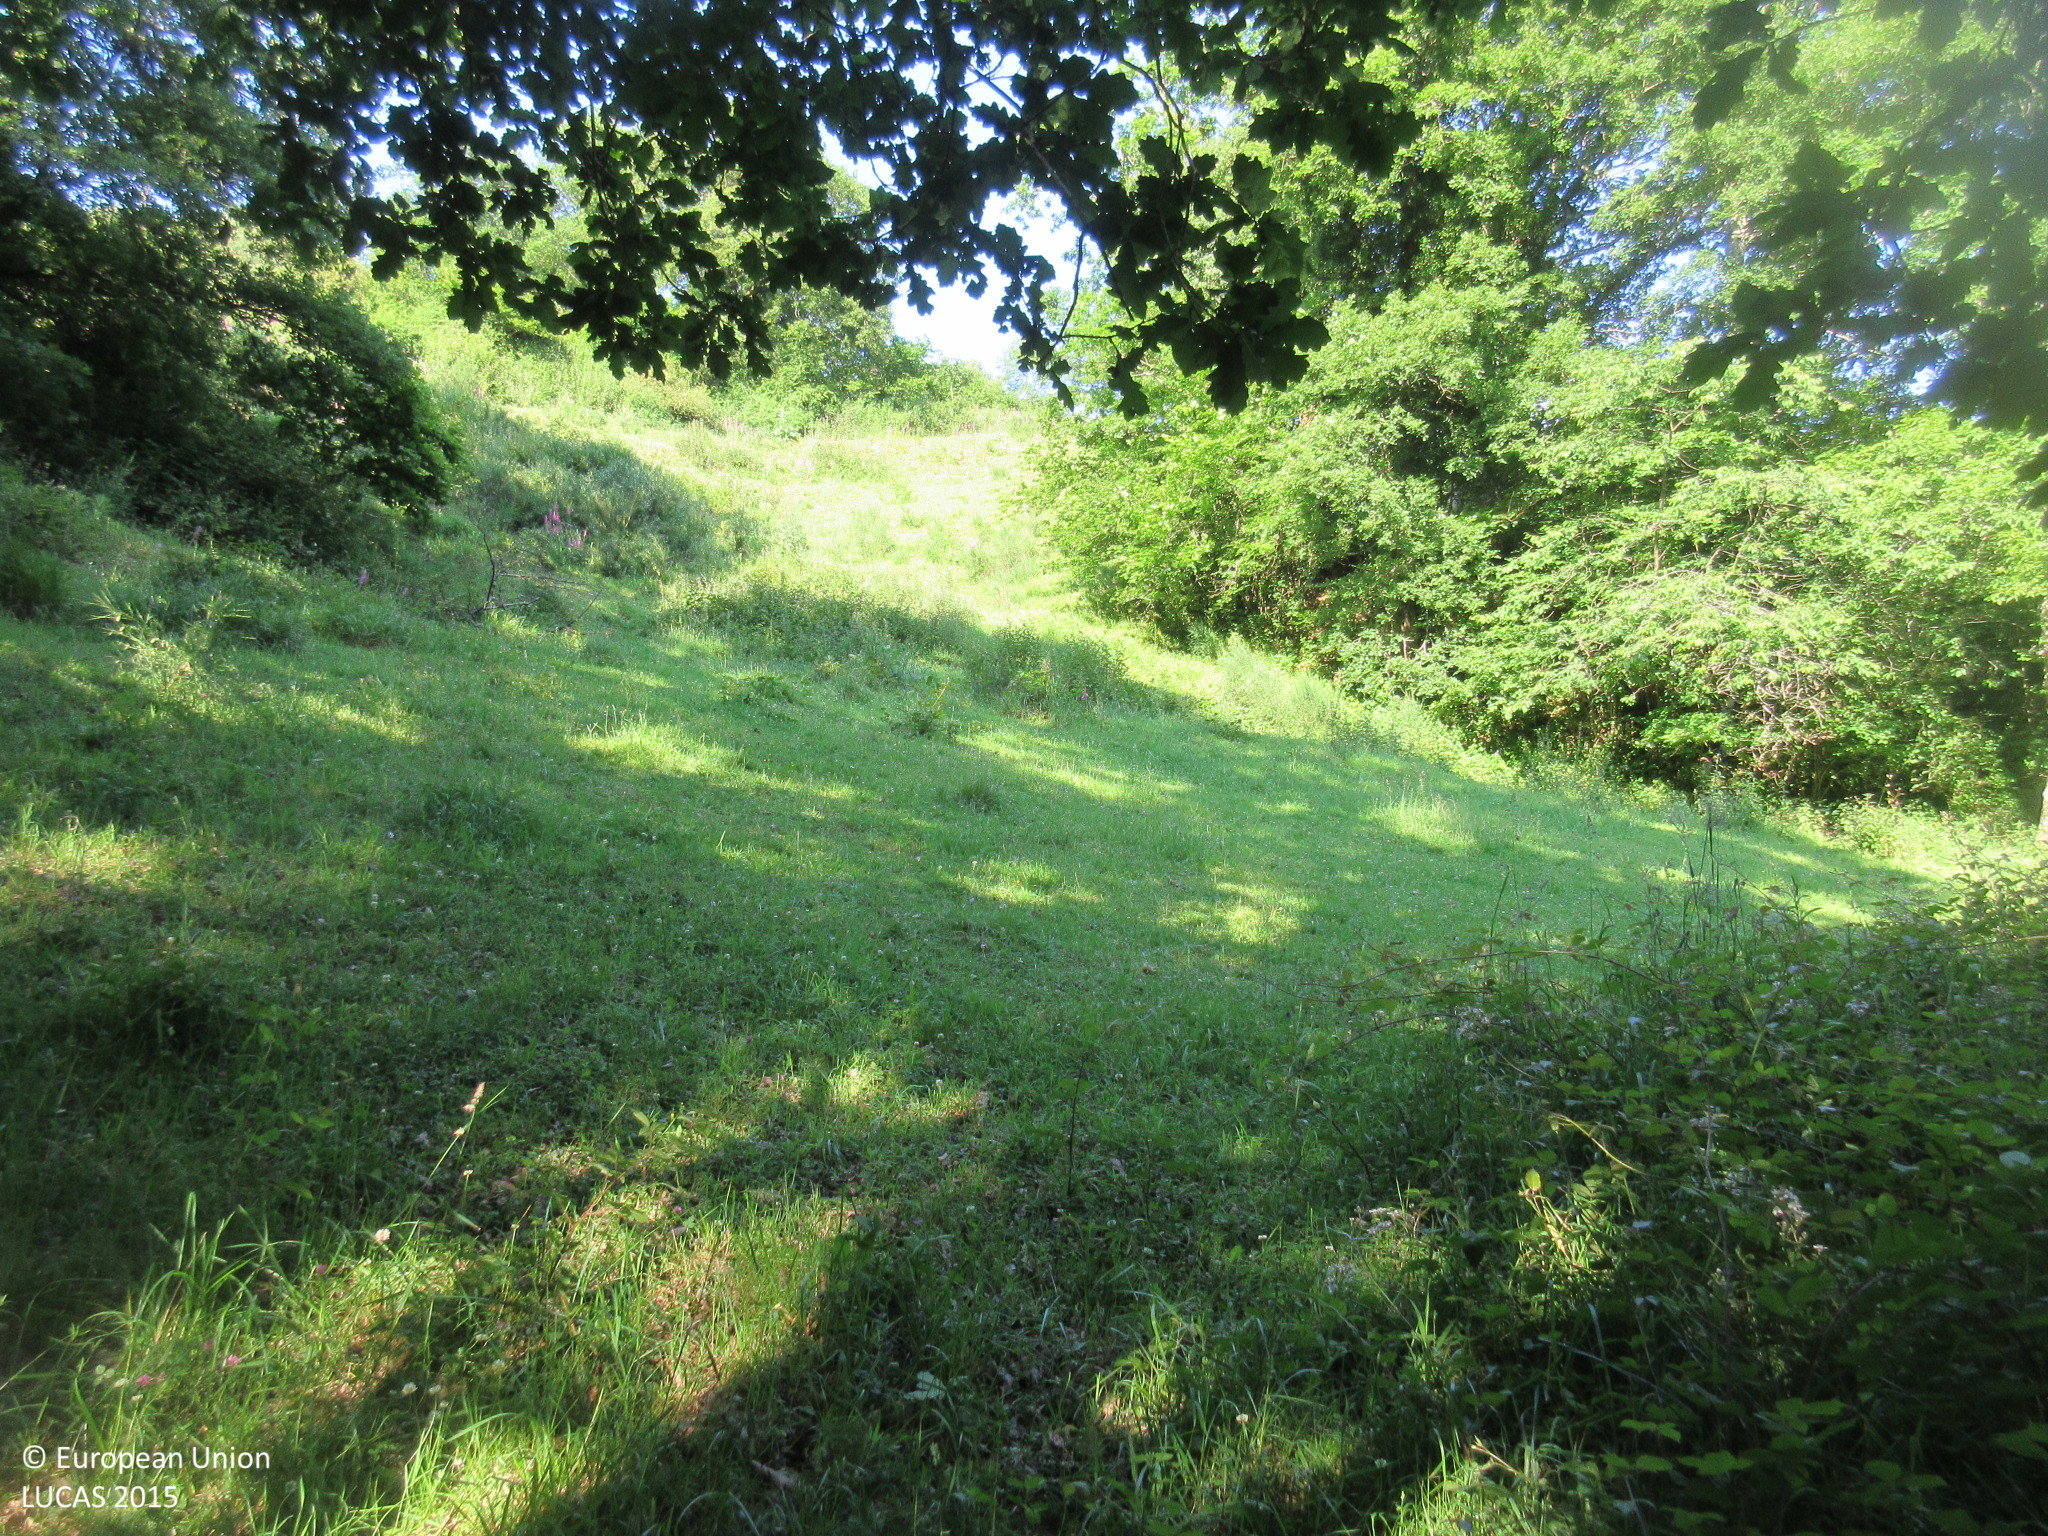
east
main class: Woodland
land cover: Broadleaved woodland
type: acidophilous oak and oak-birch forest
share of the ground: 50 - 75 %
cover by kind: broadleaved forest trees 60 %, shrubs 40 %
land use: Semi-natural and natural areas not in use
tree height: > 5 m
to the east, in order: Broadleaved woodland; Inland fresh running water; Broadleaved woodland; Grassland without tree/shrub cover; Fences; Groves
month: June
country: ES
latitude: 43.2757
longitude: -6.2753
